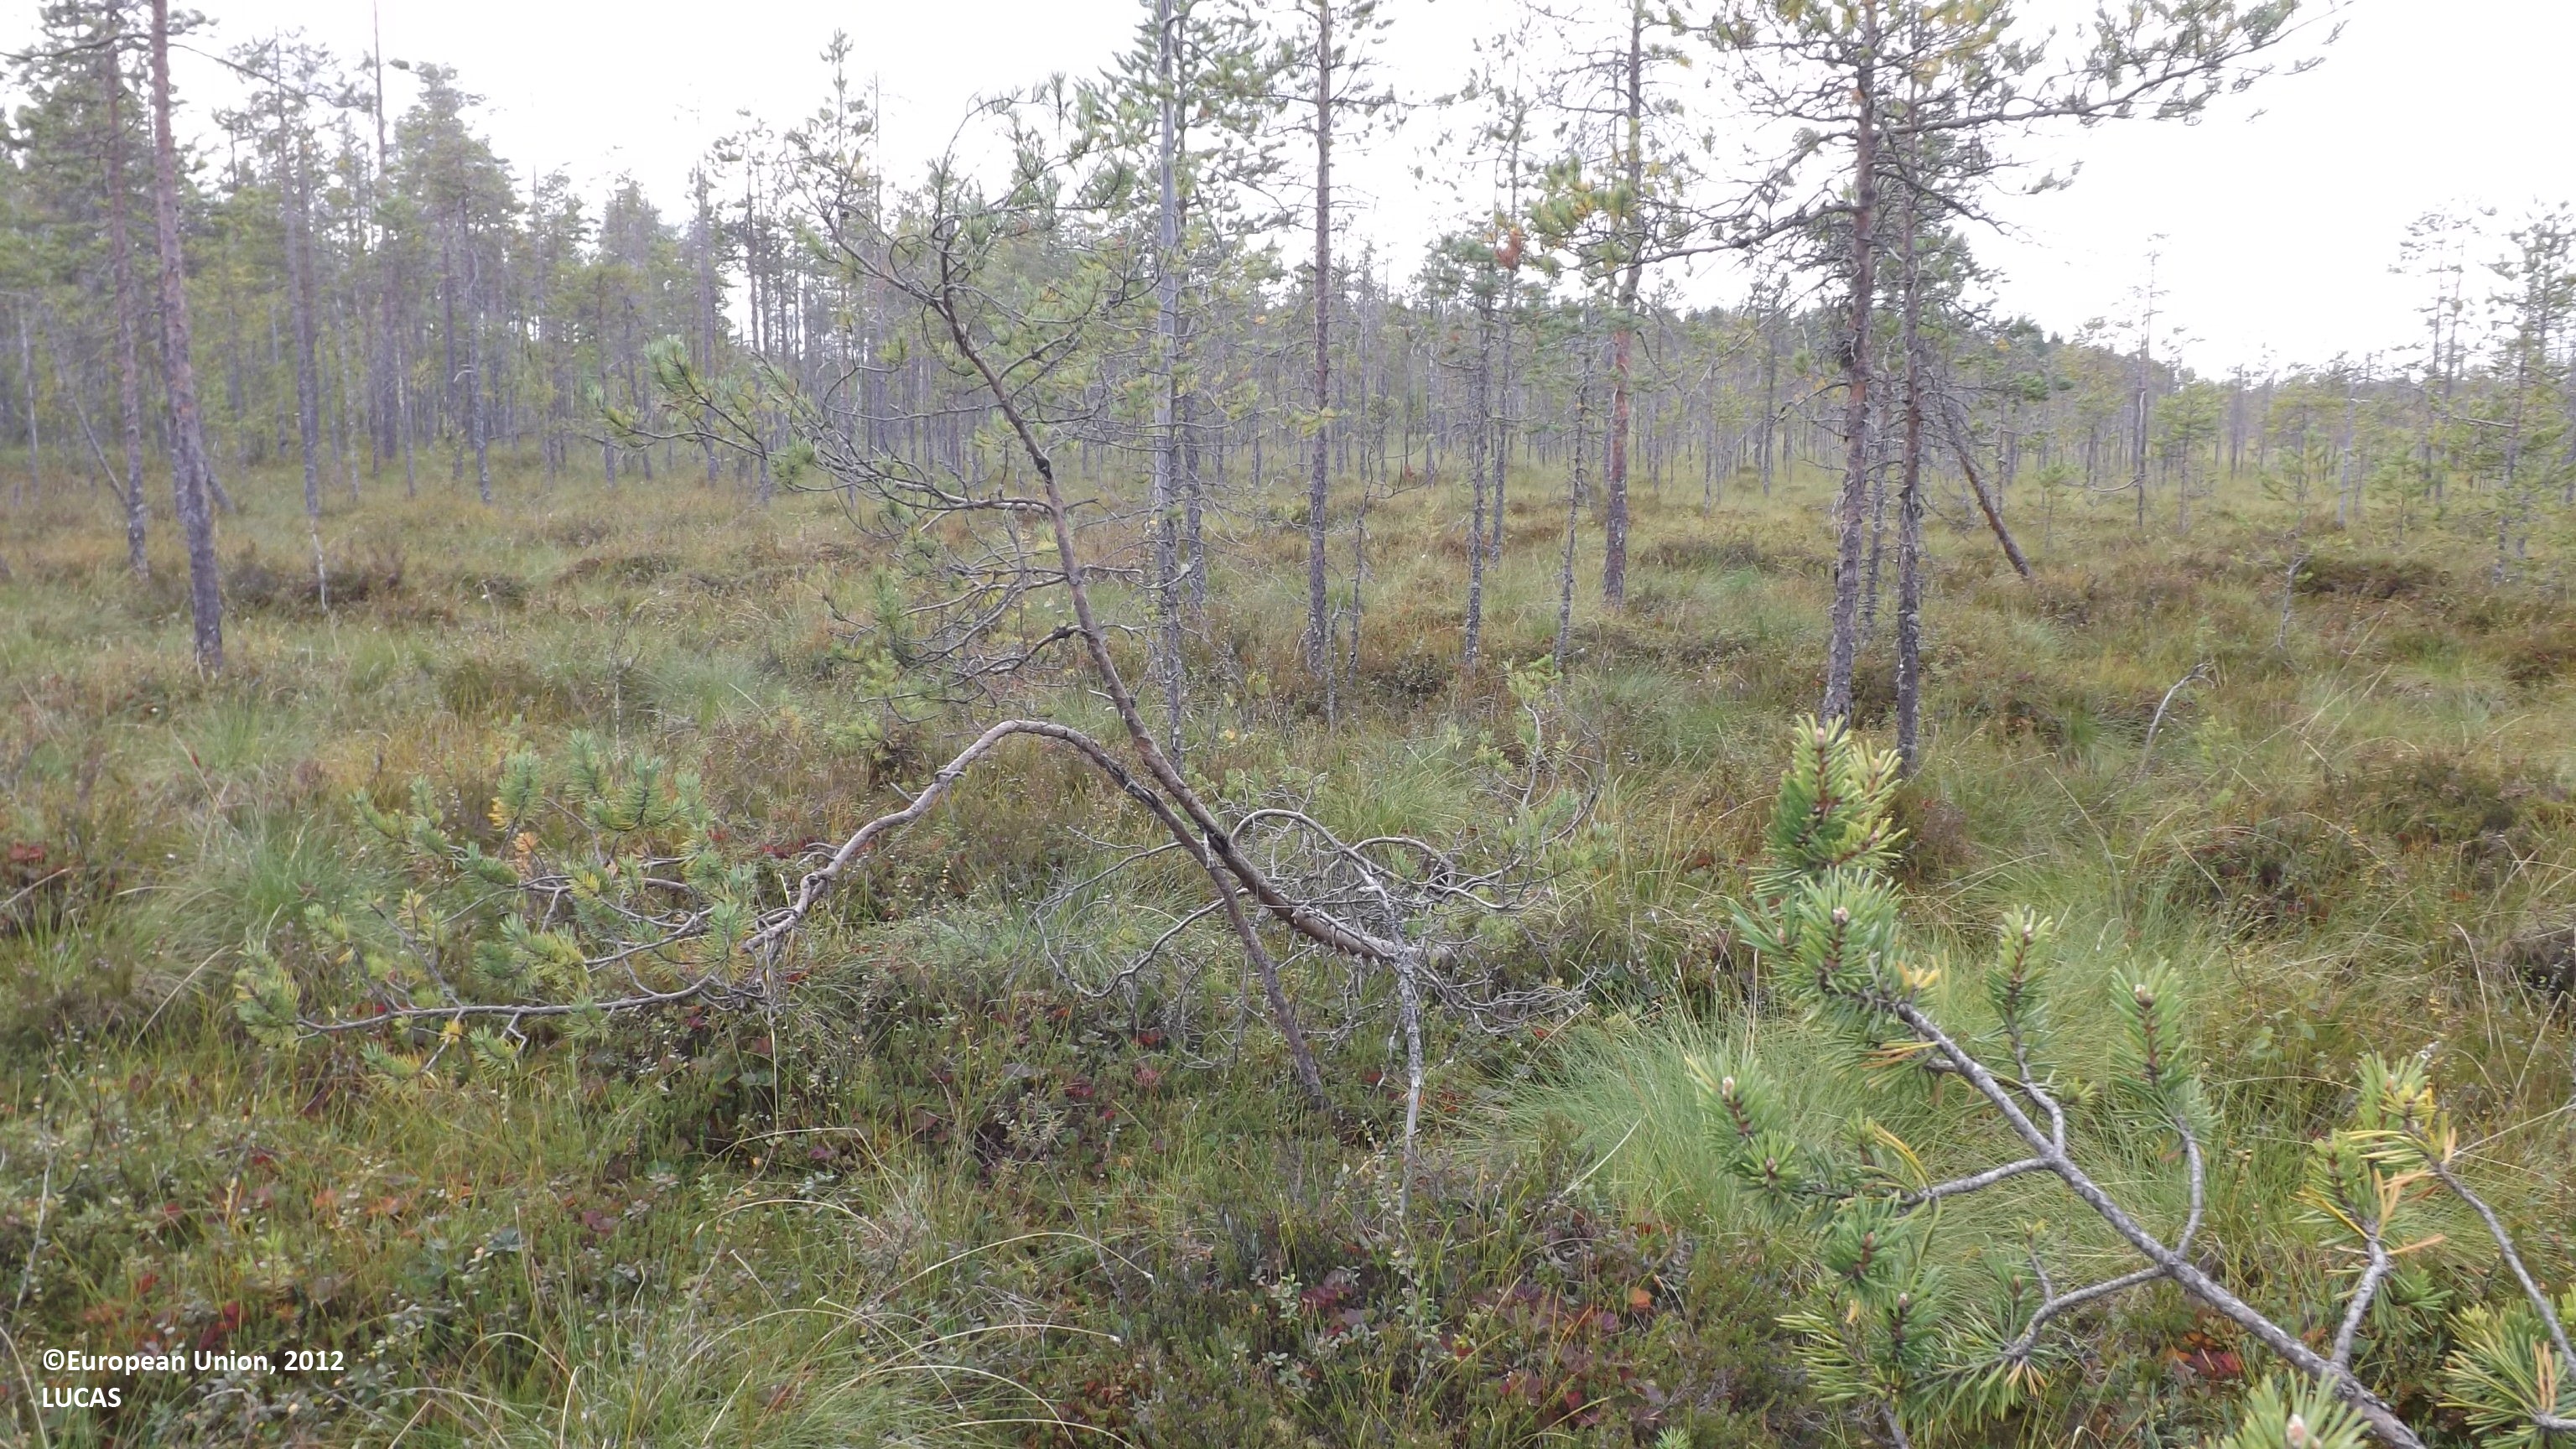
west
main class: Woodland
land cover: Pine dominated coniferous woodland
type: mire and swamp forests
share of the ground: 10 - 25 %
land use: Semi-natural and natural areas not in use
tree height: > 5 m
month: August
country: FI
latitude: 63.7839
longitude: 24.0892
